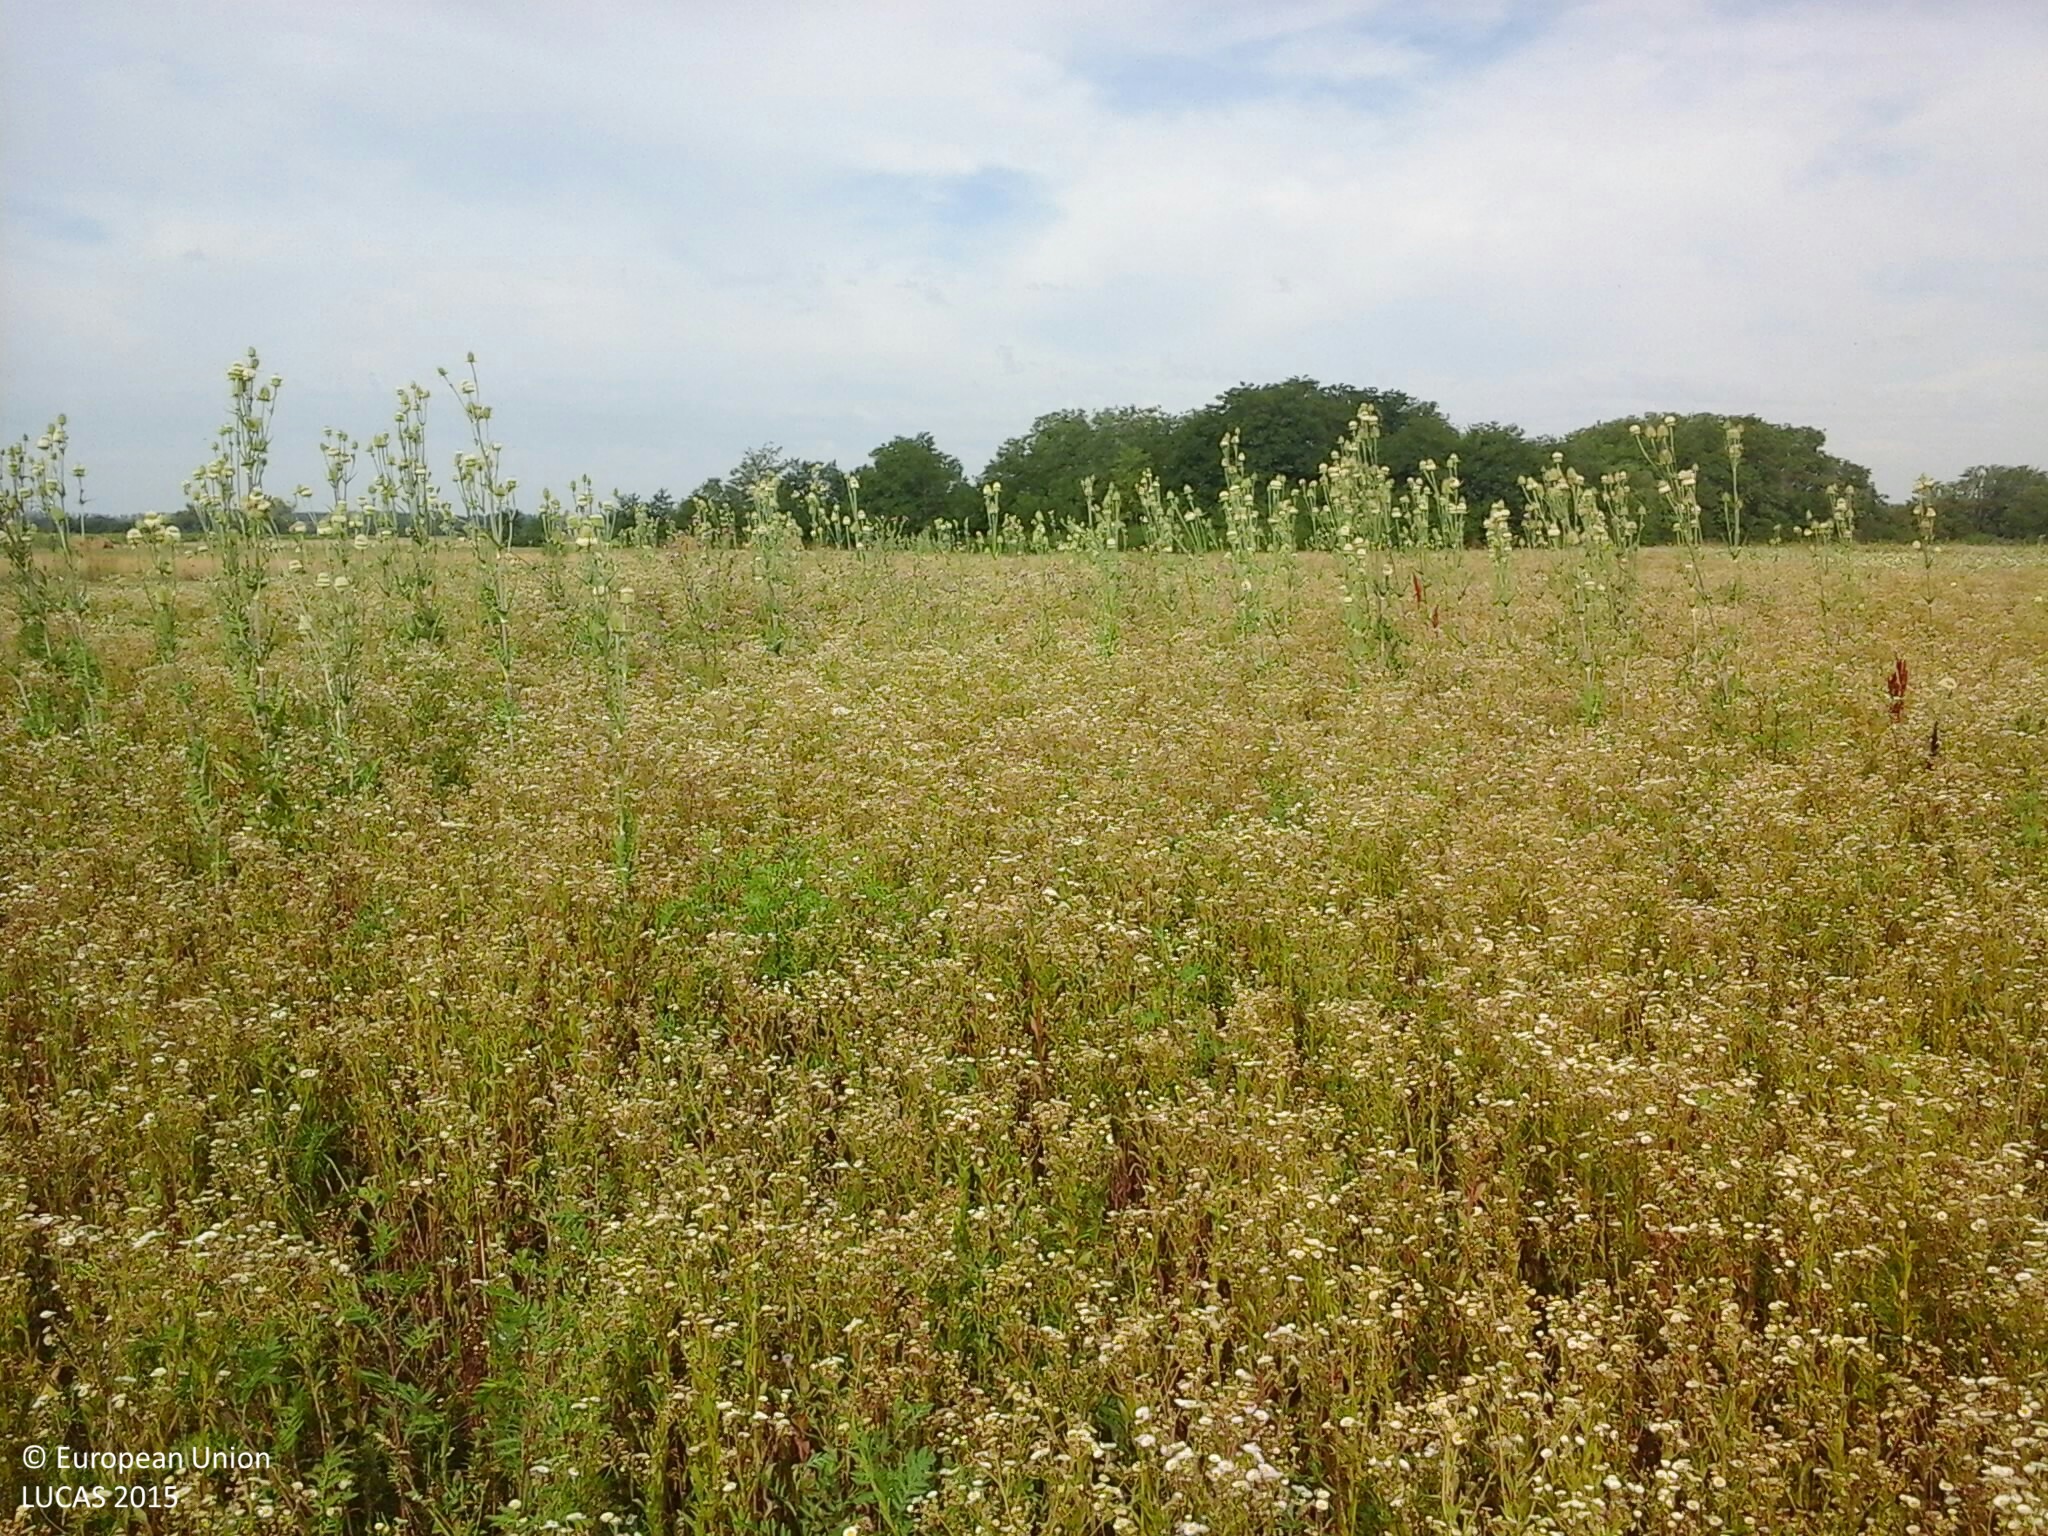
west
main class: Grassland
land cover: Spontaneously vegetated surfaces
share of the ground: > 75 %
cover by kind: herbaceous plants 100 %
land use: Abandoned areas
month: July
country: HU
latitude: 48.2210
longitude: 22.3199
